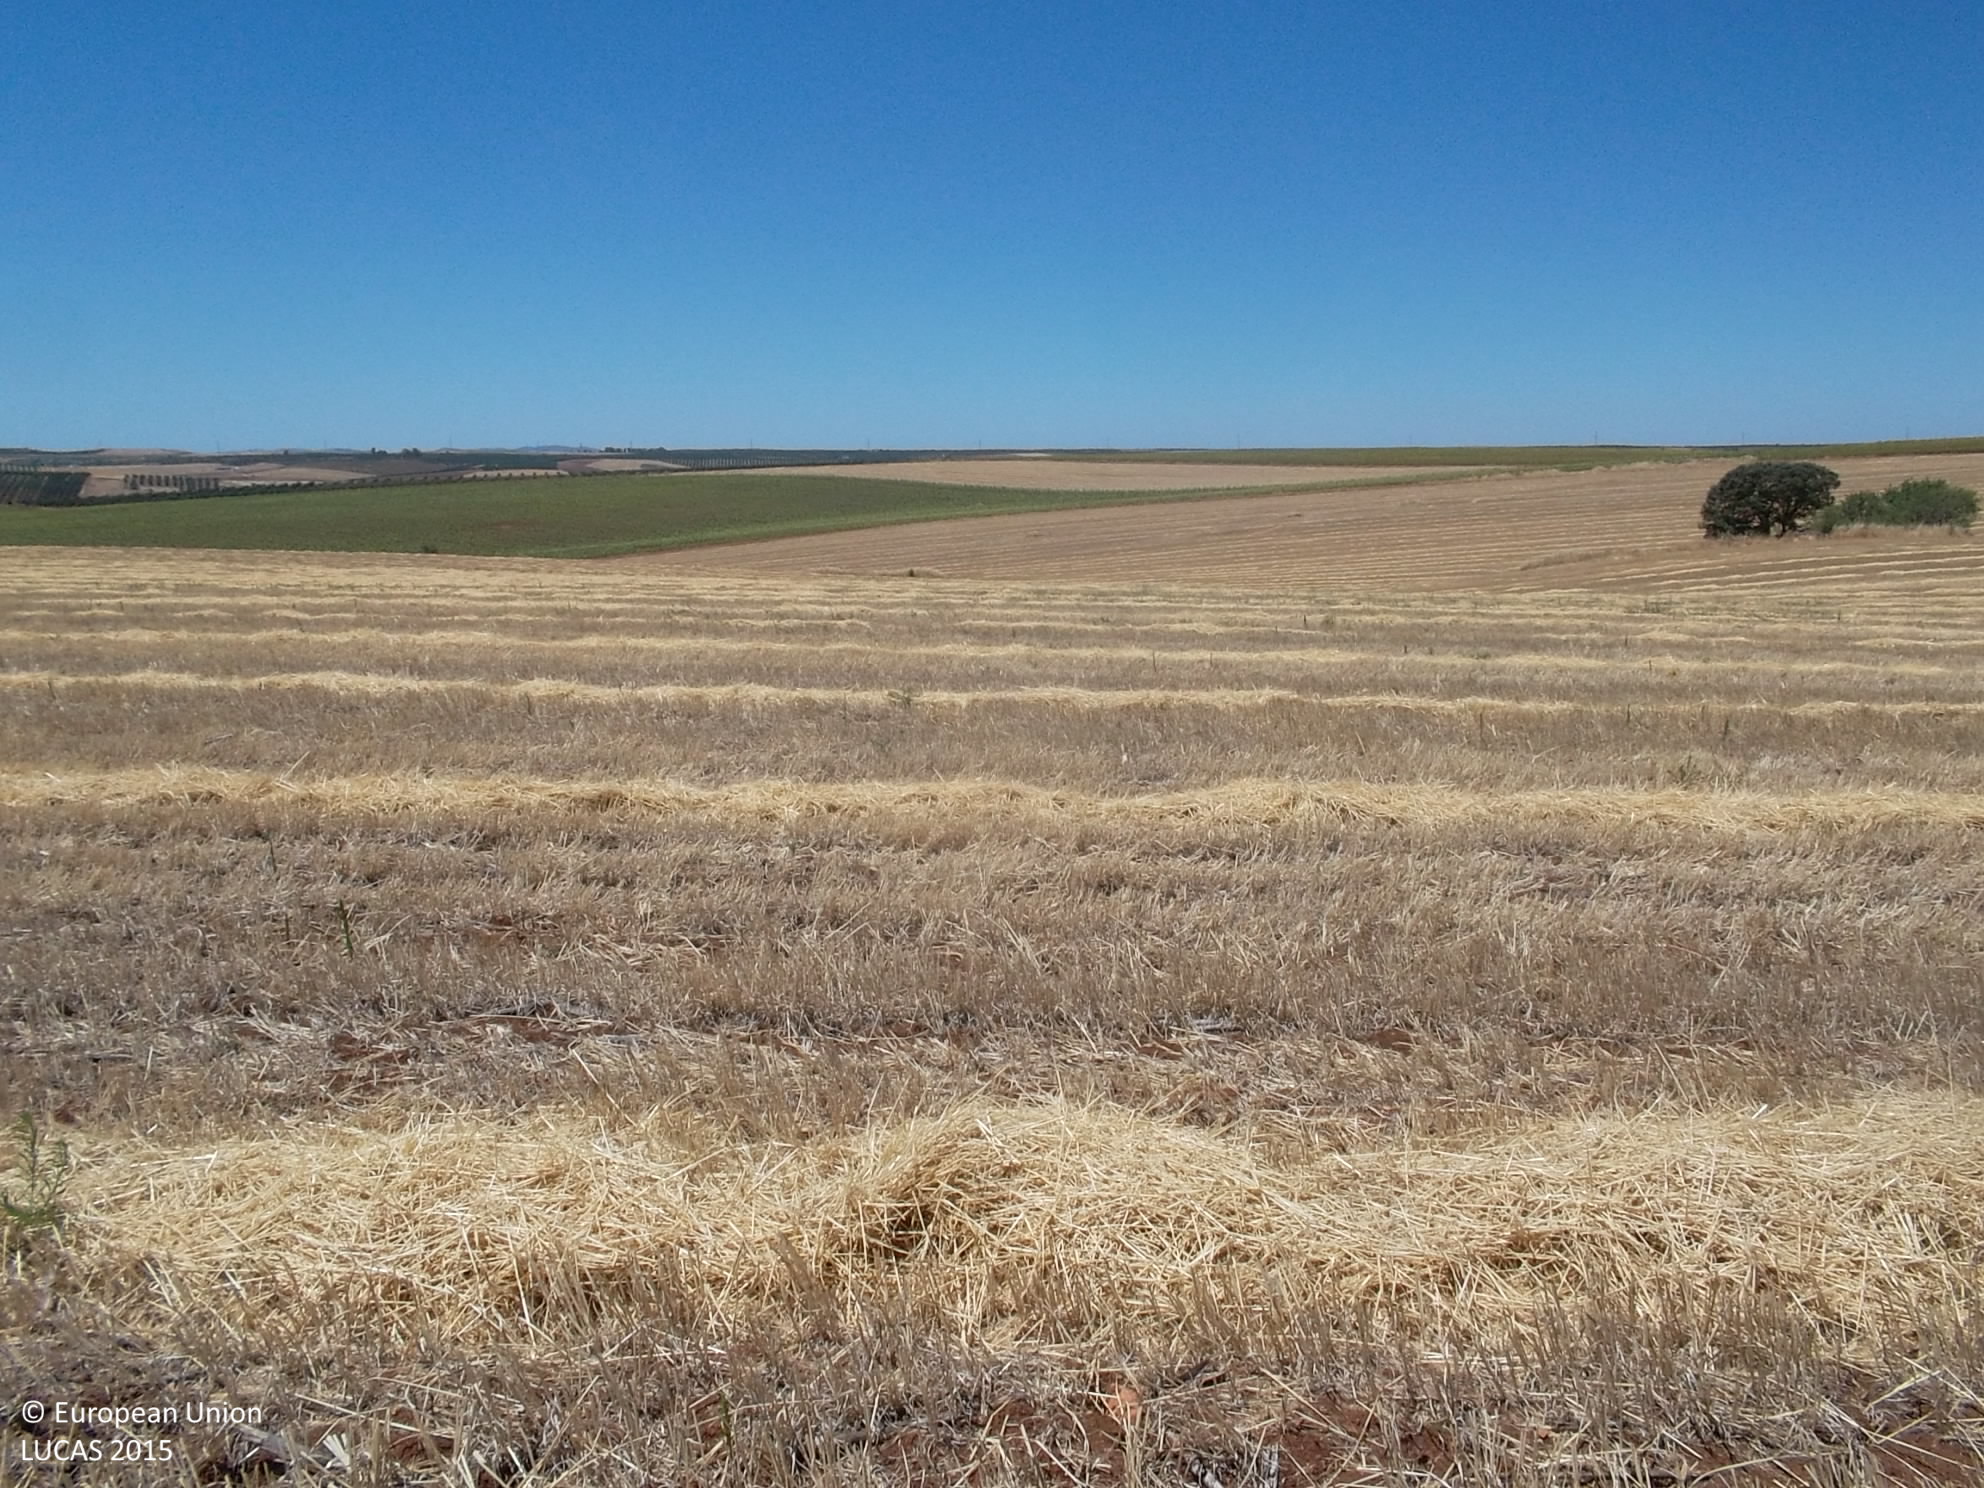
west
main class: Cropland
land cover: Barley
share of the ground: < 10 %
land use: Agriculture (excluding fallow land and kitchen gardens)
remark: Harvested field
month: July
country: ES
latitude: 38.3316
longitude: -5.8132
